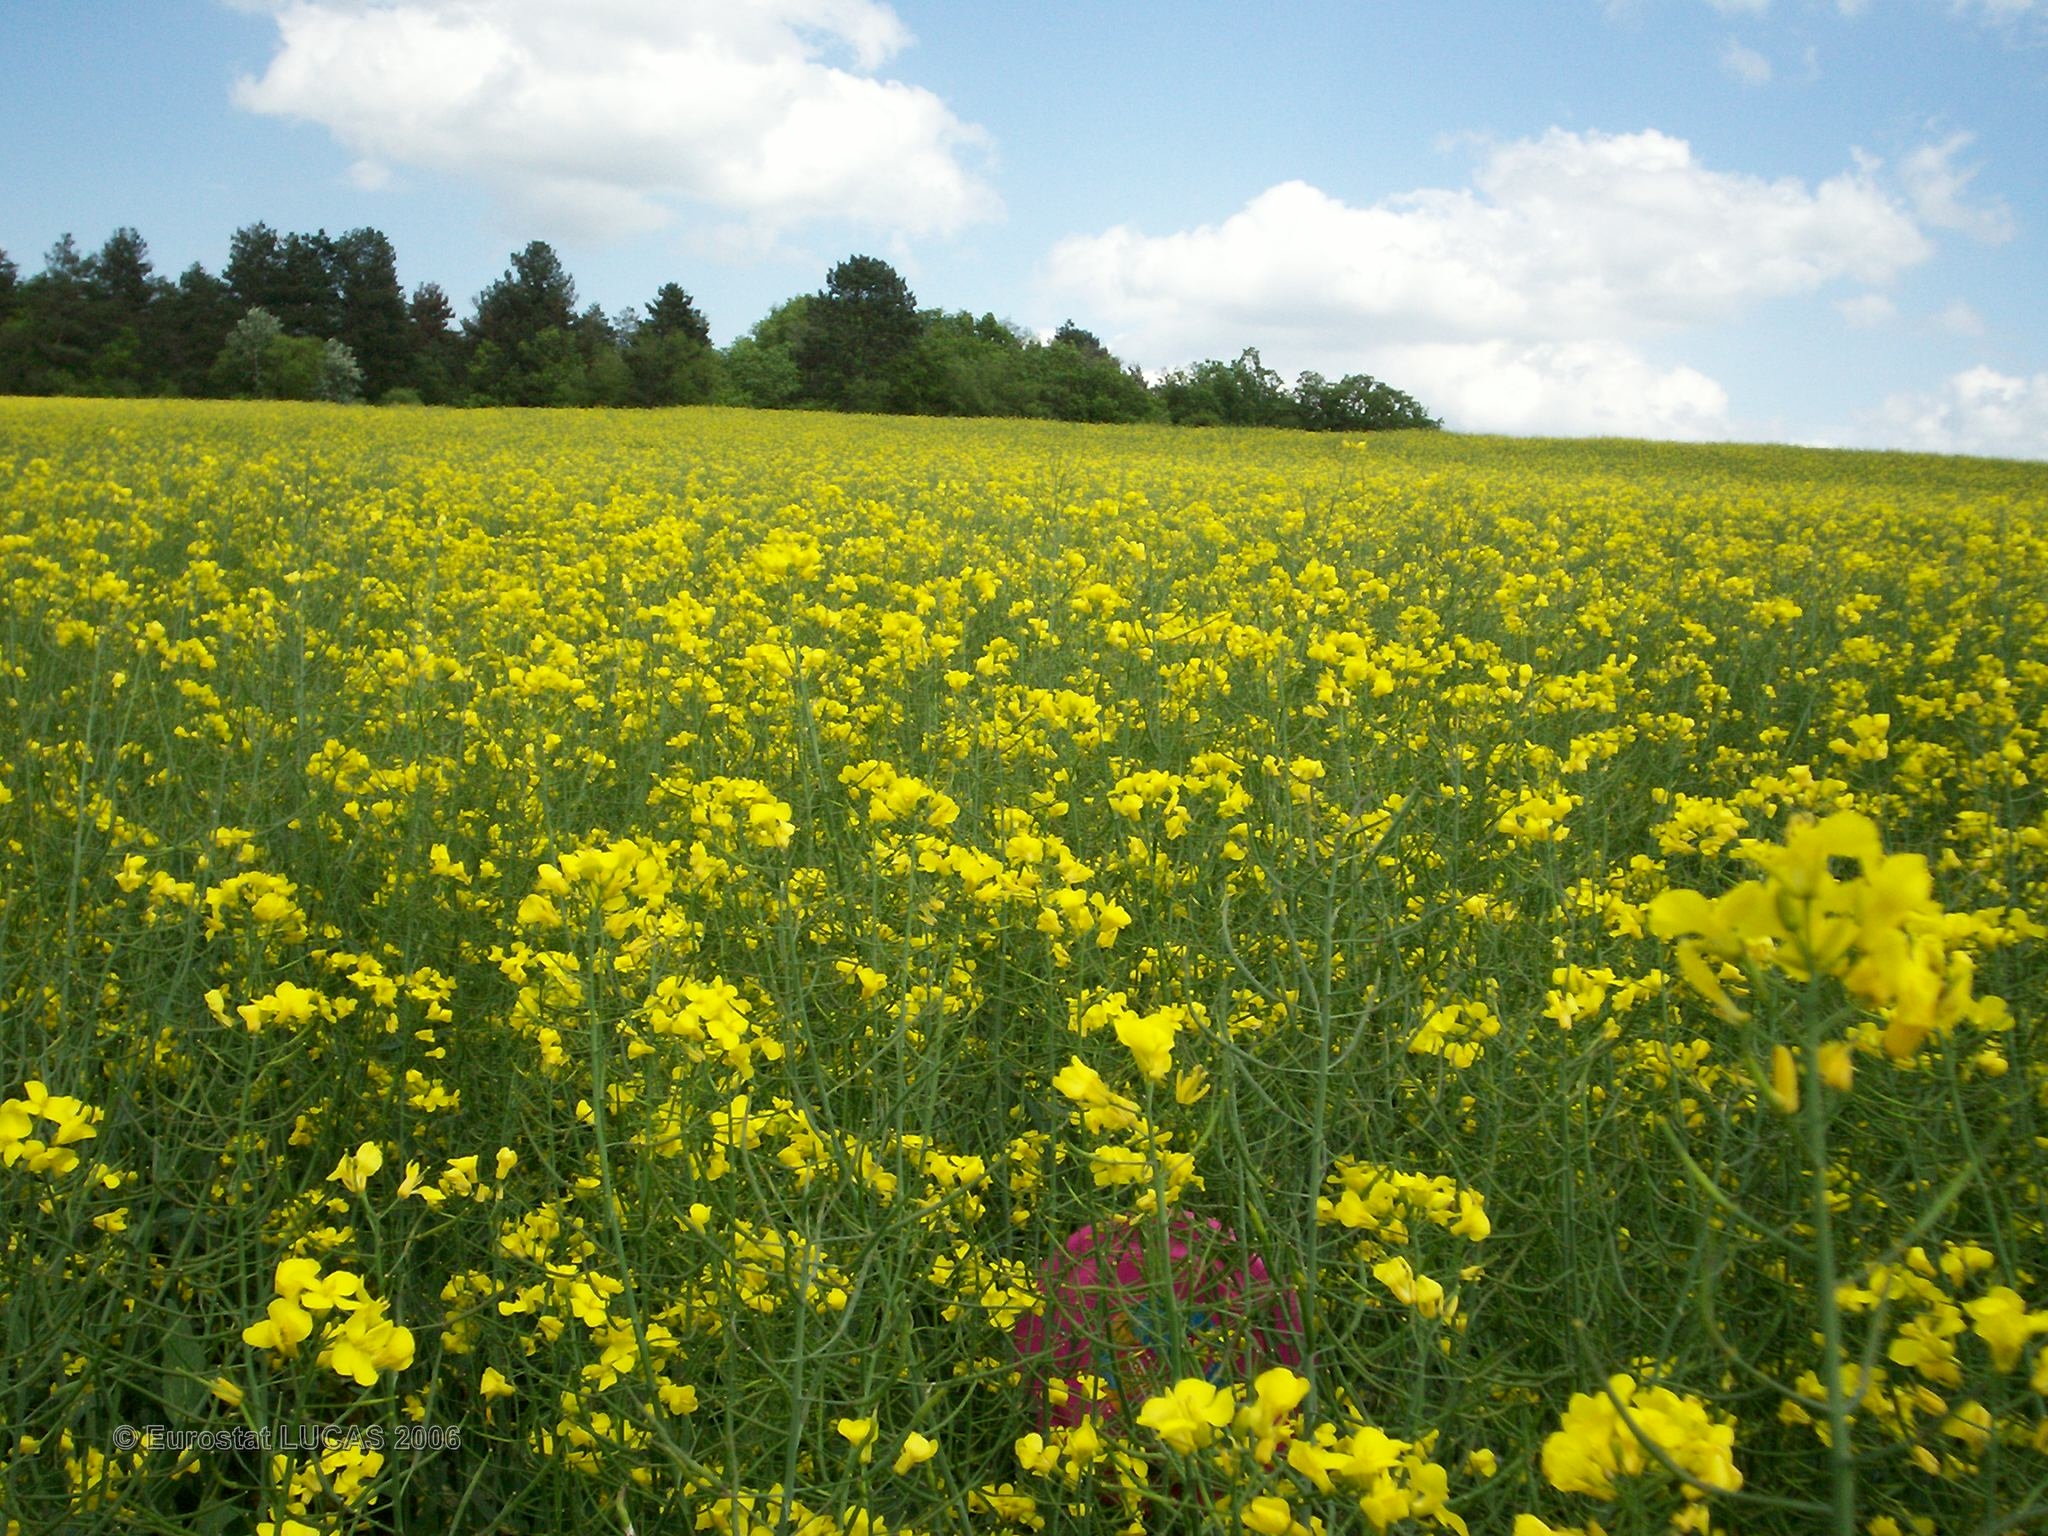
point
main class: Cropland
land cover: Rape and turnip rape
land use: Agriculture (excluding fallow land and kitchen gardens)
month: May
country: FR
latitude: 47.6491
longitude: 4.0735
